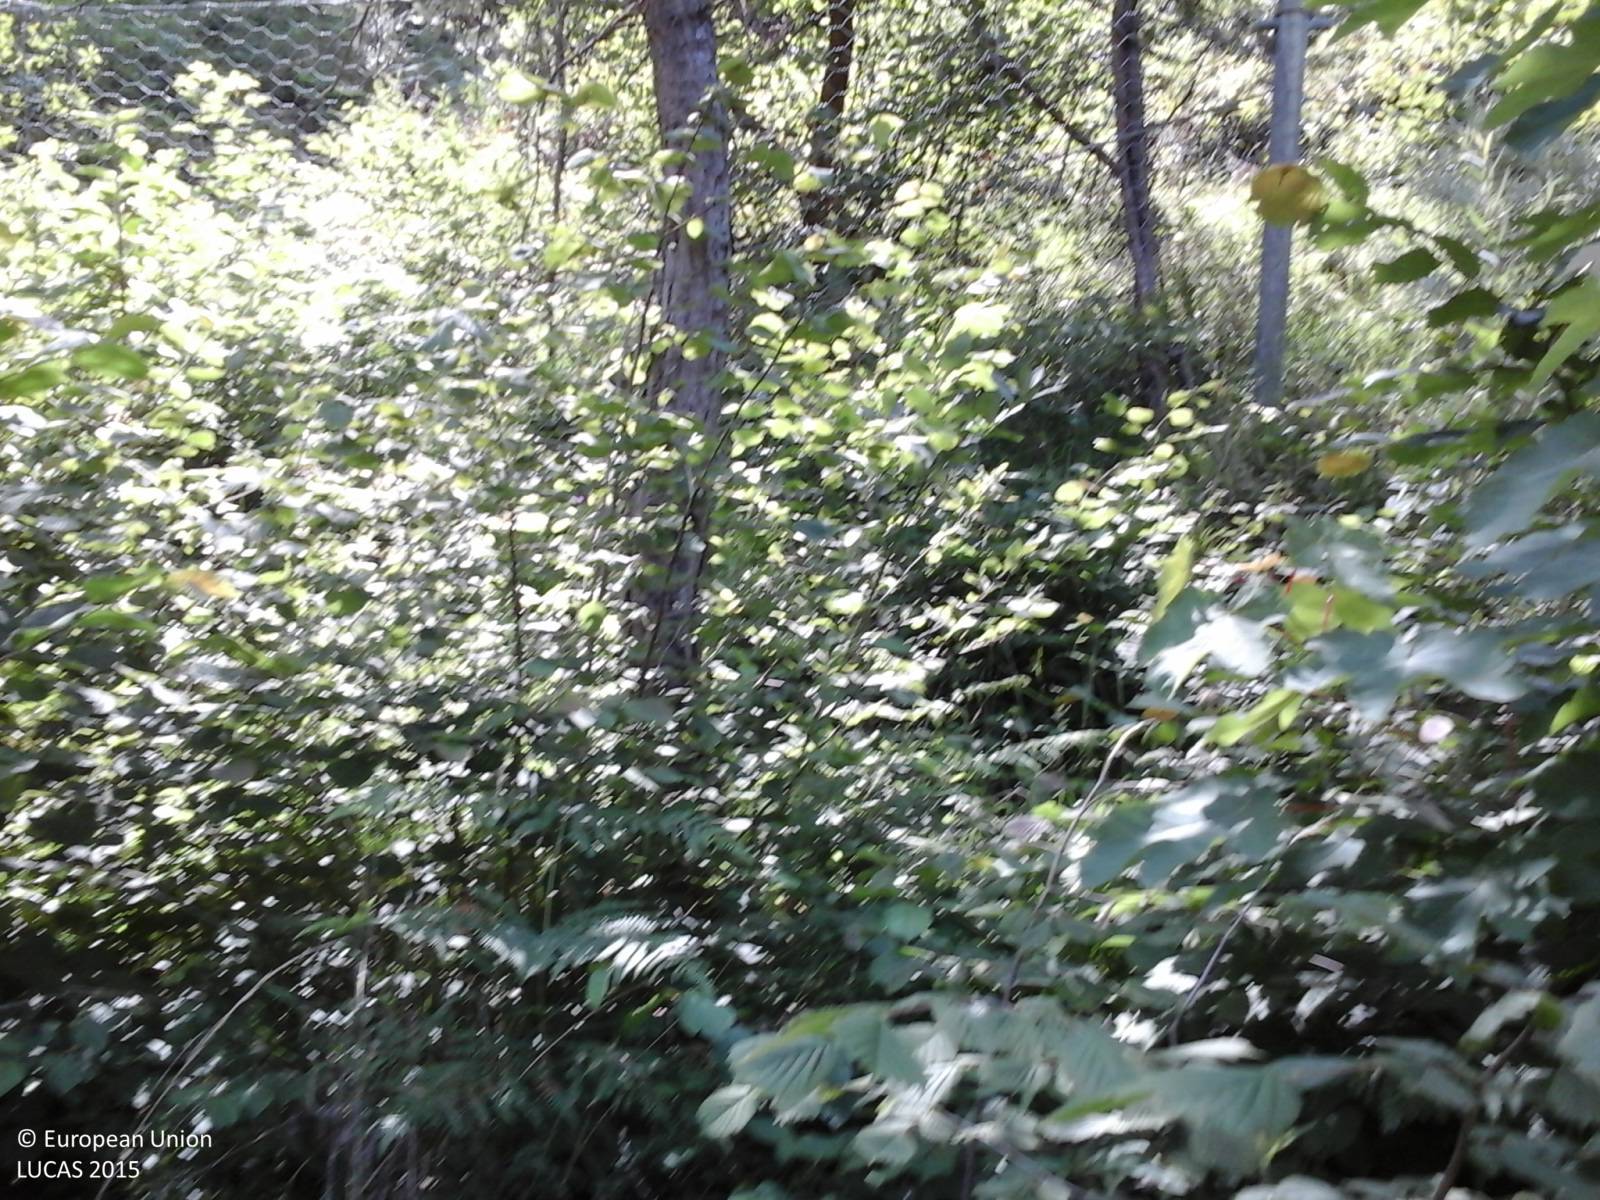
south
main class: Woodland
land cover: Pine dominated coniferous woodland
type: alpine coniferous forest
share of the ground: > 75 %
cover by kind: coniferous forest trees 70 %, broadleaved forest trees 10 %, shrubs 10 %, herbaceous plants 10 %
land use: Semi-natural and natural areas not in use
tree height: > 5 m
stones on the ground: 25 - 50 %
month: June
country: IT
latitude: 46.3924
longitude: 13.2350
